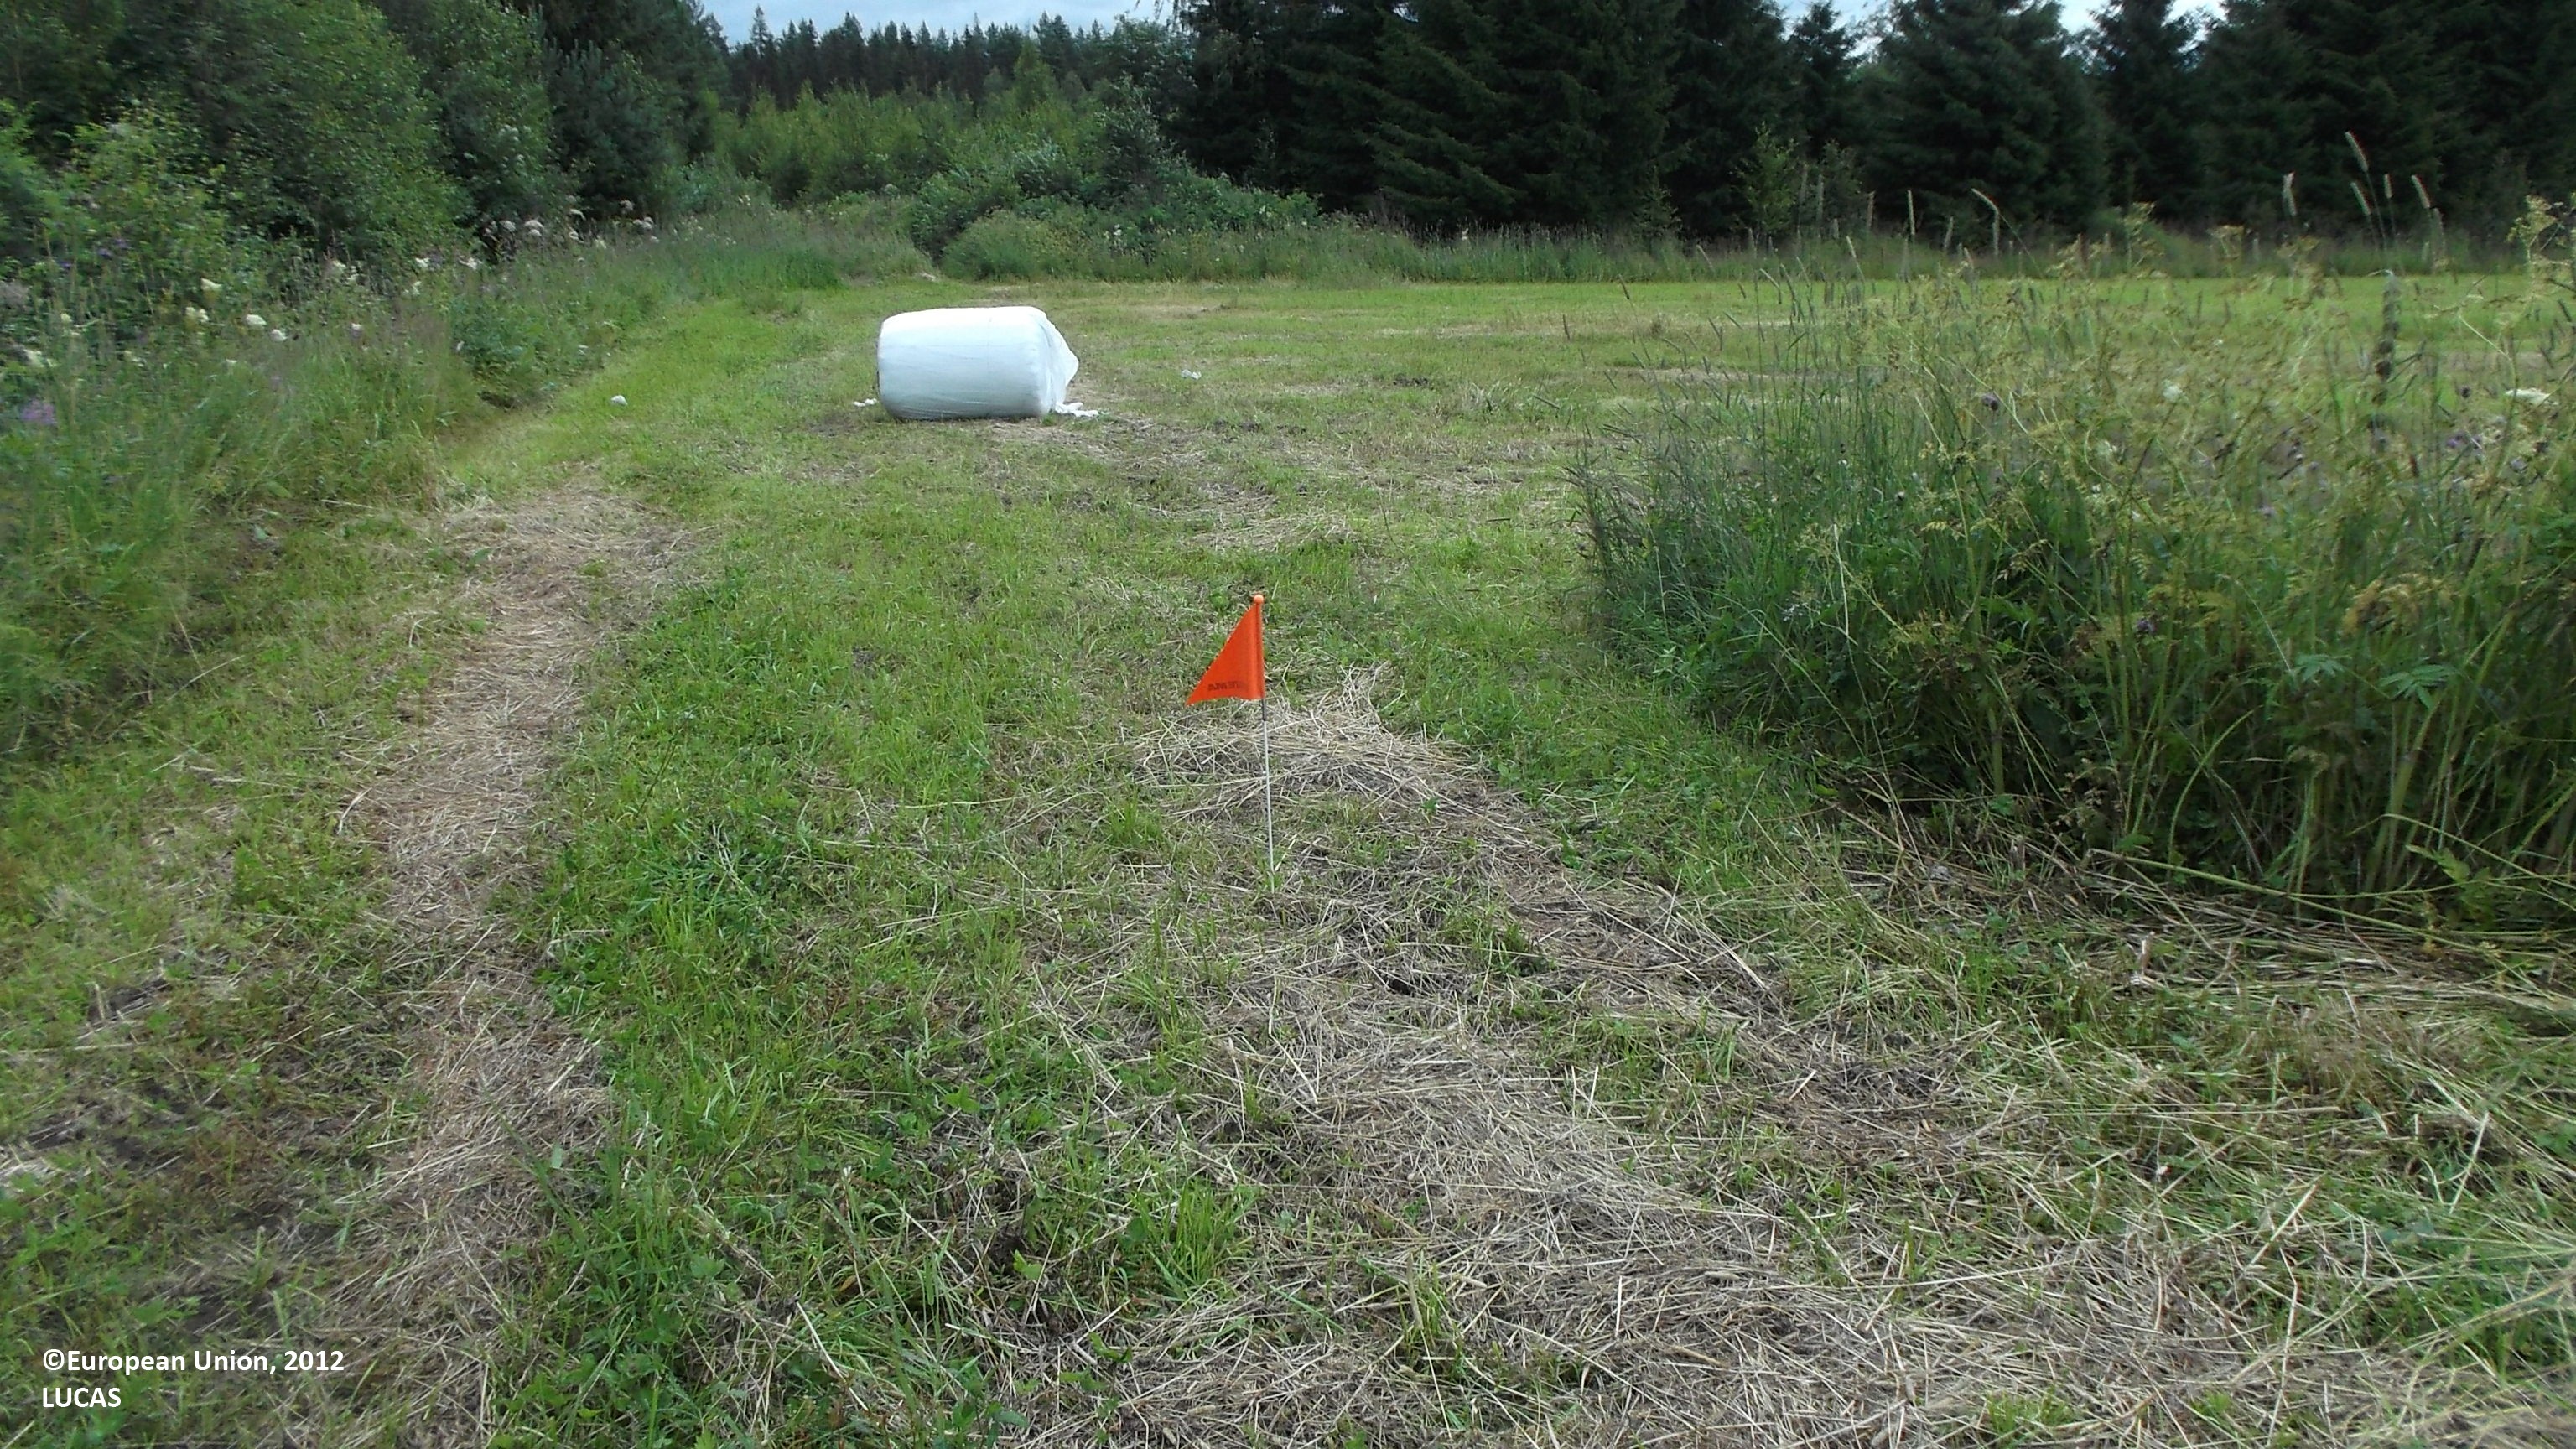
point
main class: Cropland
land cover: Temporary grasslands
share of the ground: > 75 %
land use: Agriculture (excluding fallow land and kitchen gardens)
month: July
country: FI
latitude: 63.7018
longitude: 23.1437
